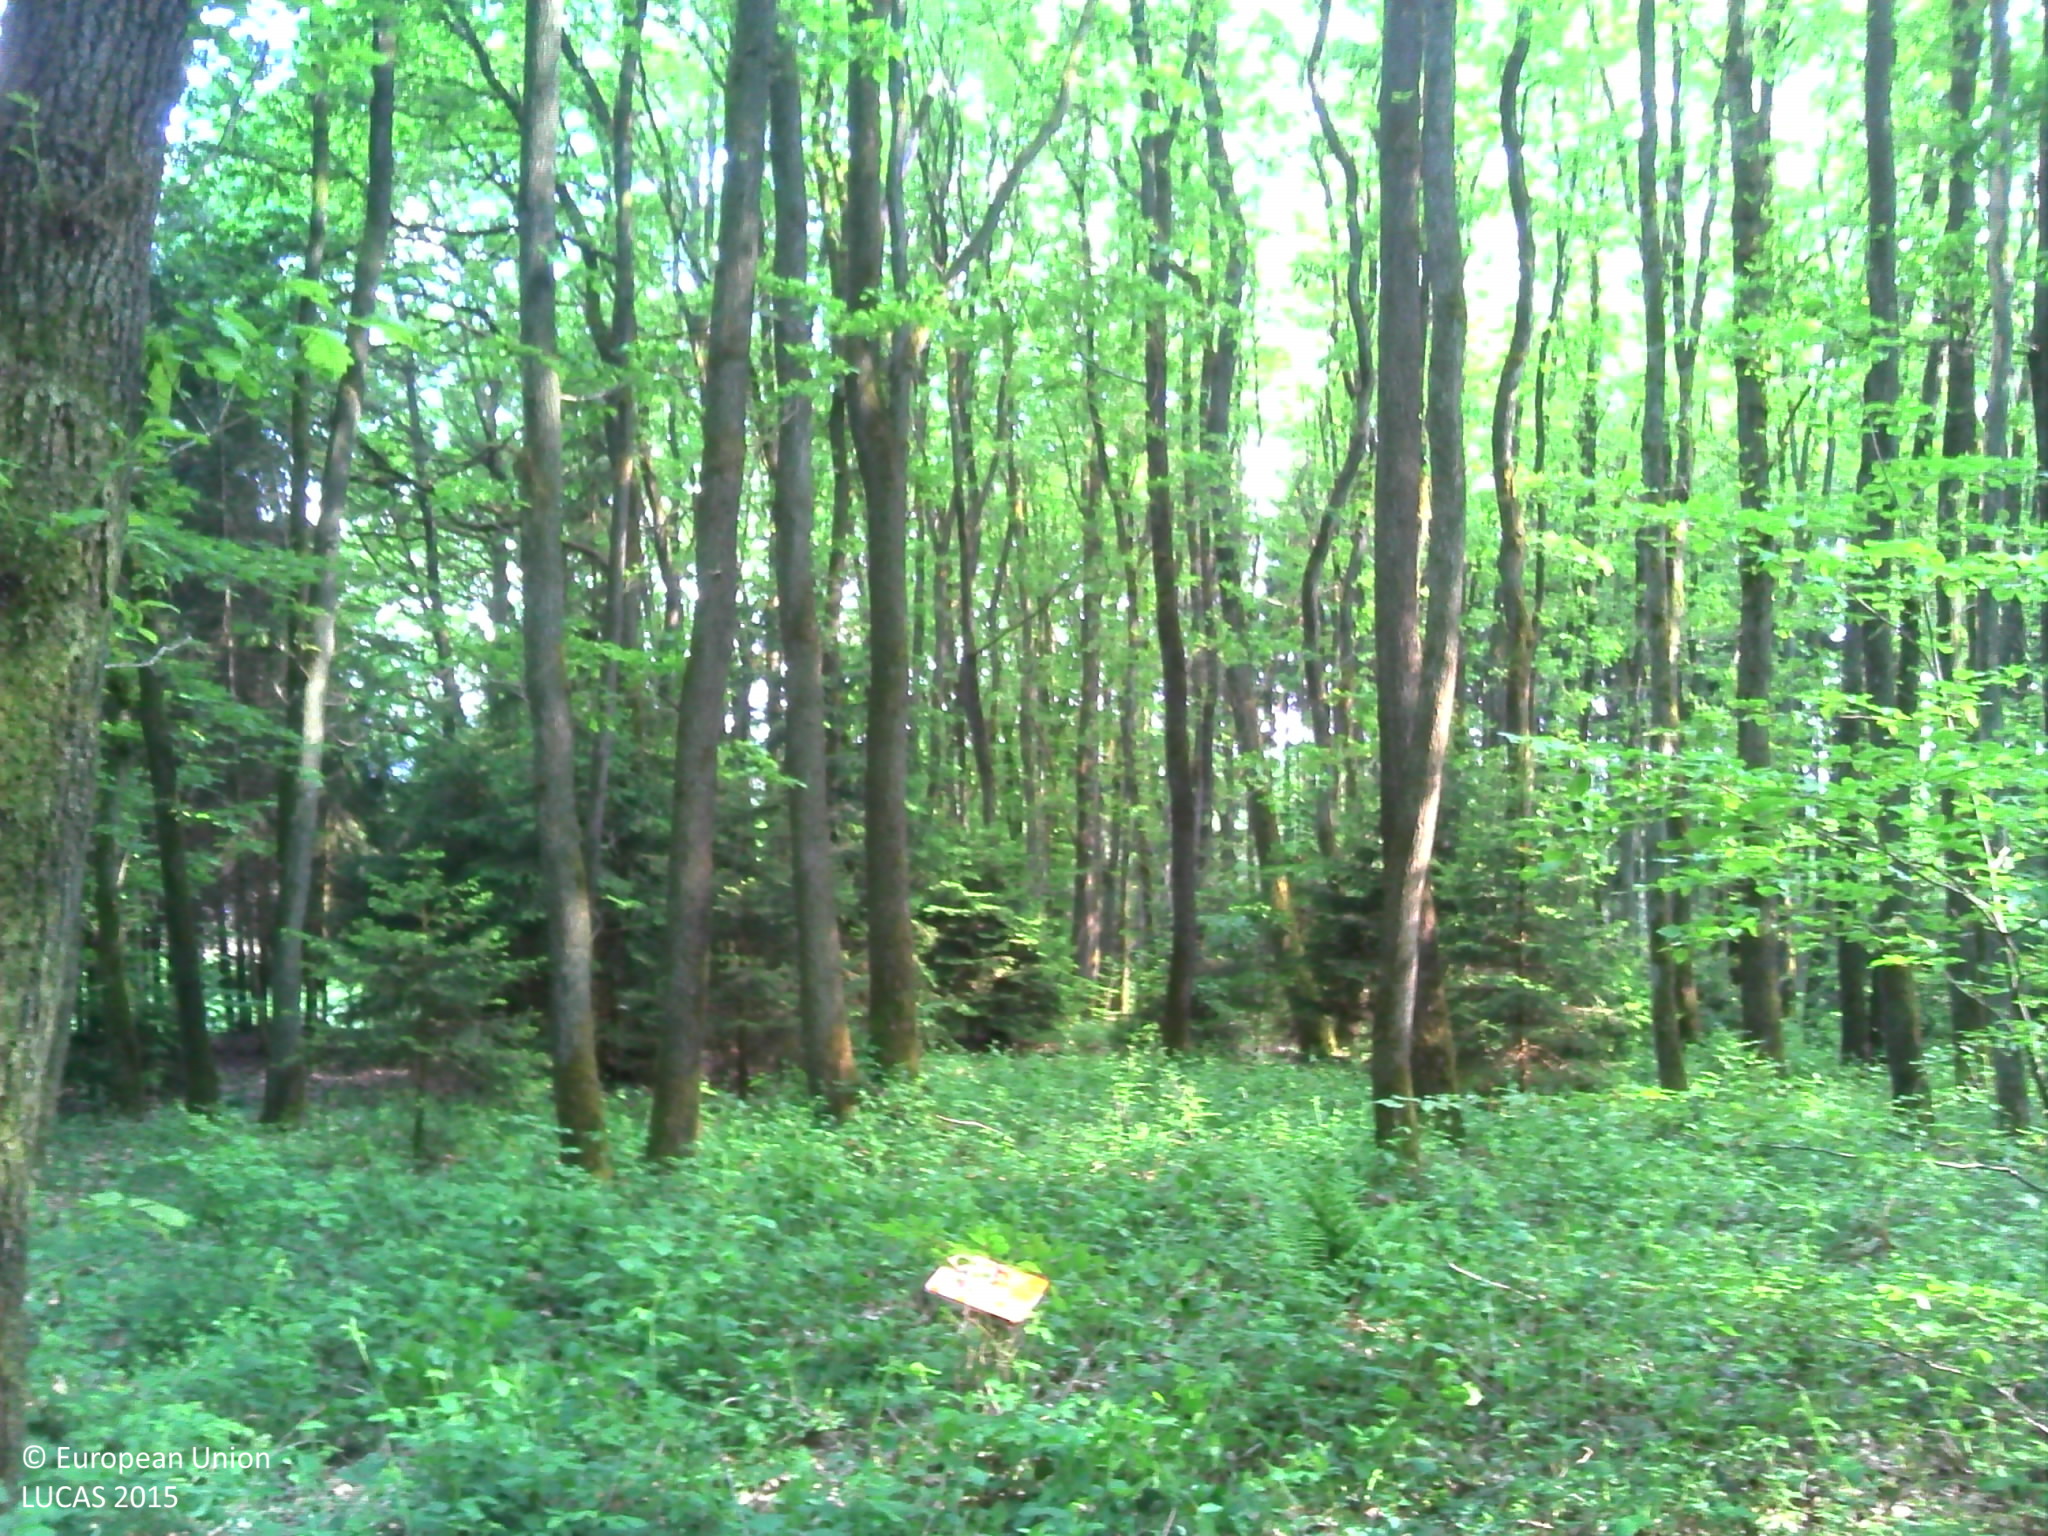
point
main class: Woodland
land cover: Broadleaved woodland
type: acidophilous oak and oak-birch forest
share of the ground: > 75 %
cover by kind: broadleaved forest trees 90 %, coniferous forest trees 10 %
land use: Forestry
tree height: > 5 m
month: May
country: LU
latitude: 49.8652
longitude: 6.0900
